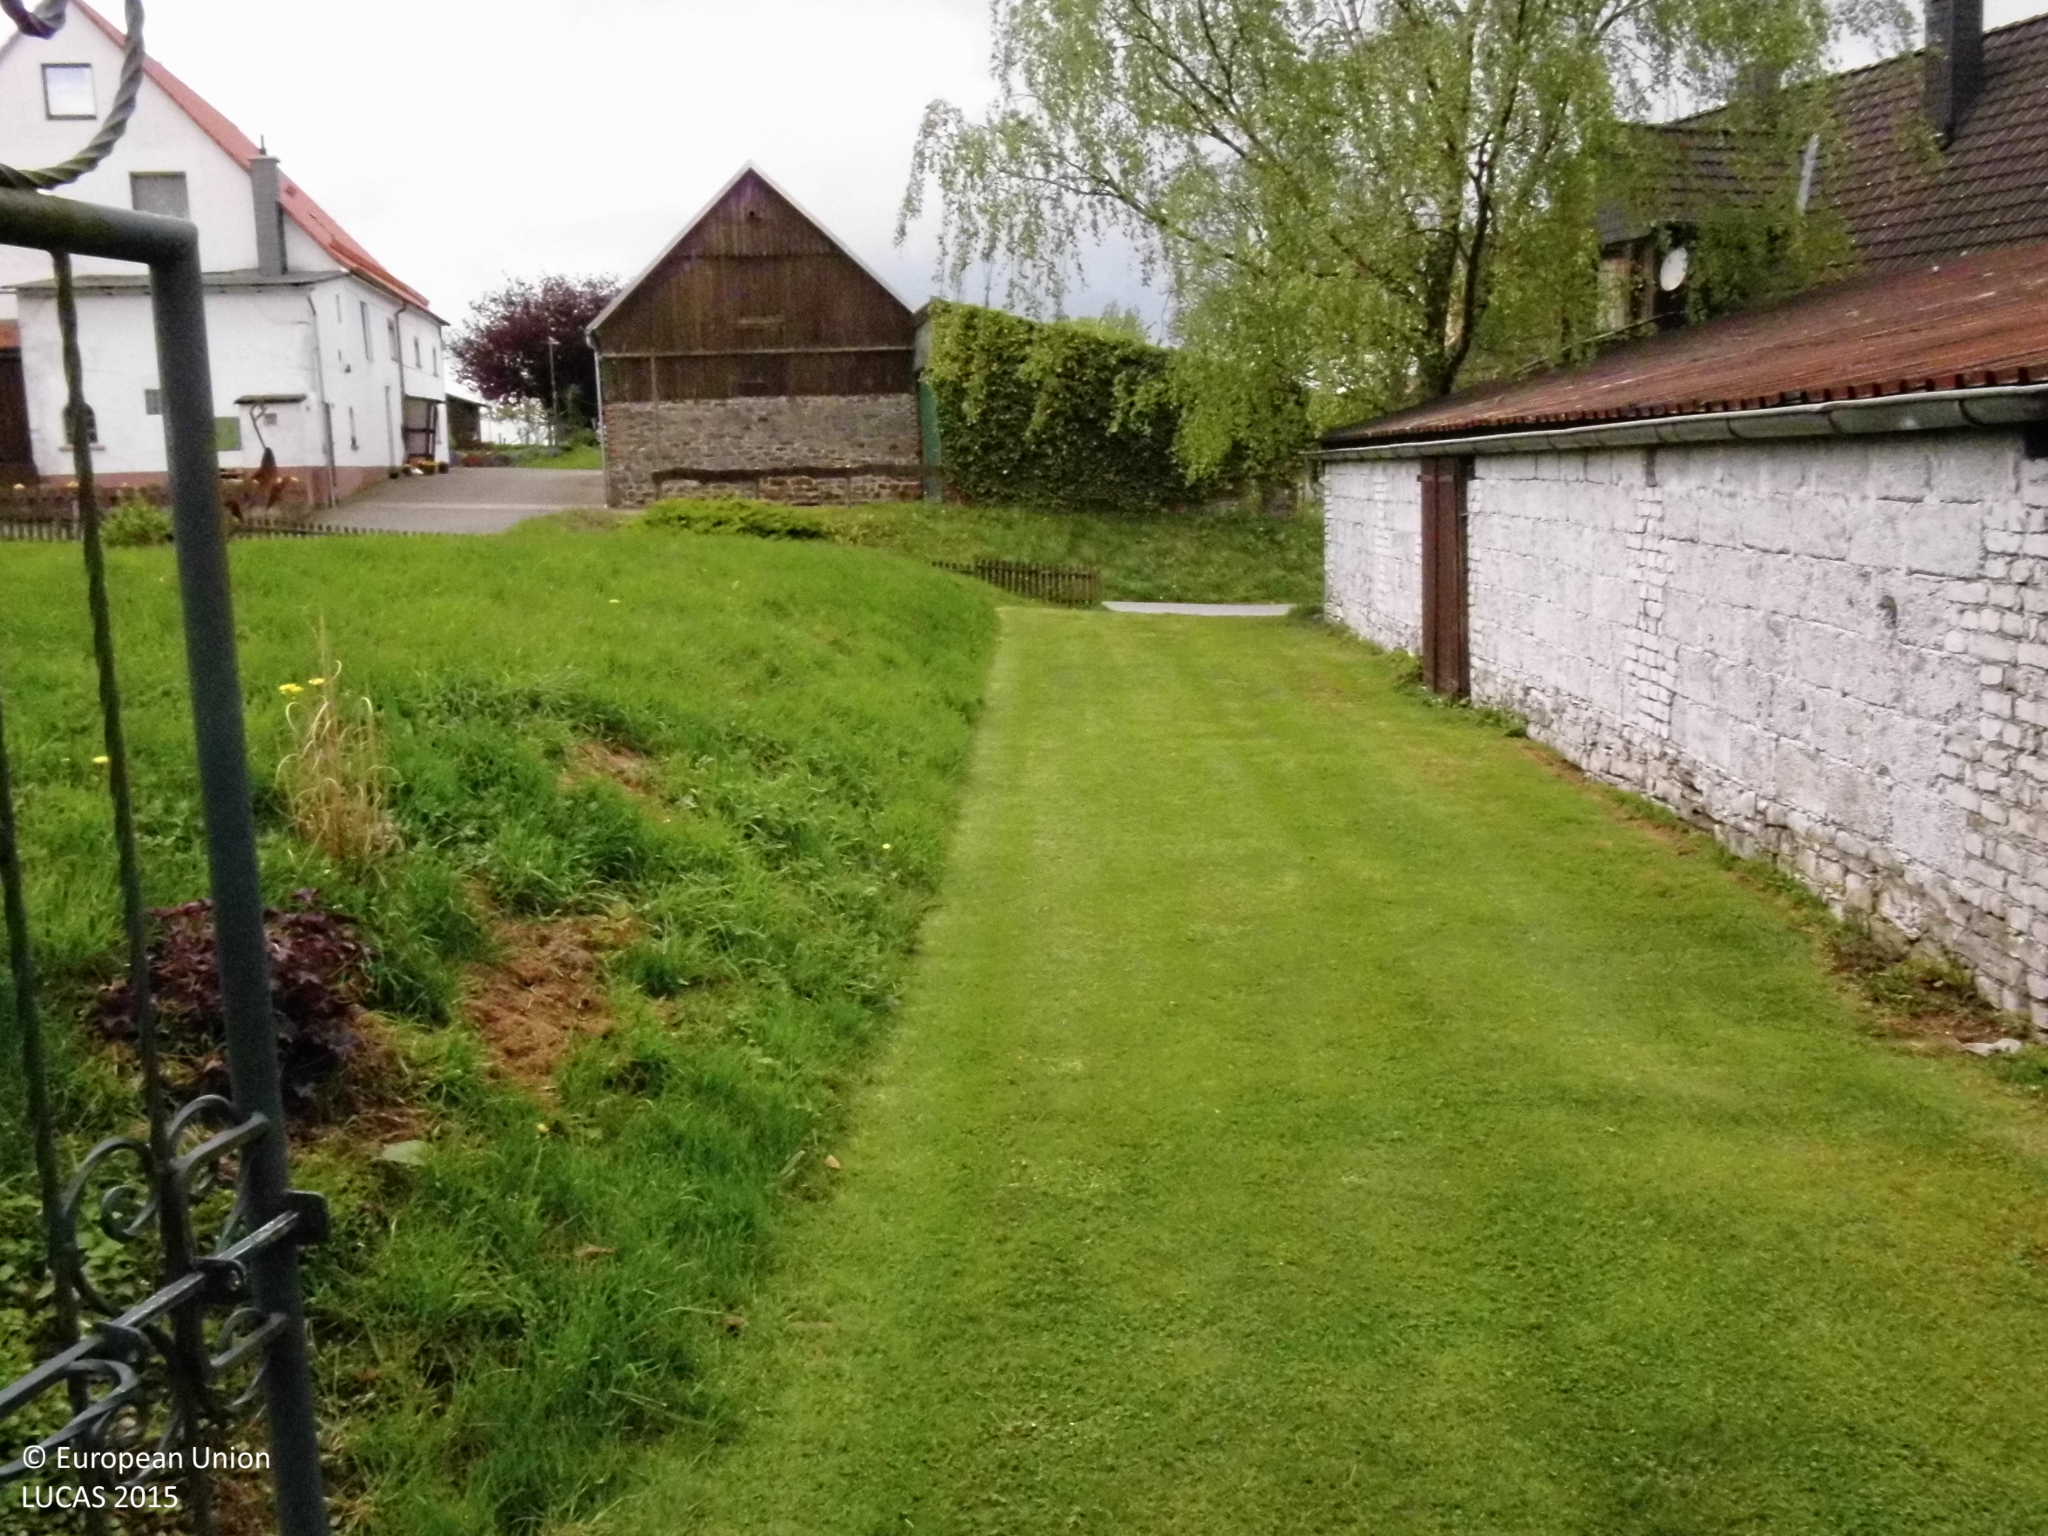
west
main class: Grassland
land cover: Grassland without tree/shrub cover
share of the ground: > 75 %
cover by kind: herbaceous plants 100 %
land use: Residential
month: May
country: DE
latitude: 51.2707
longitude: 7.4345
